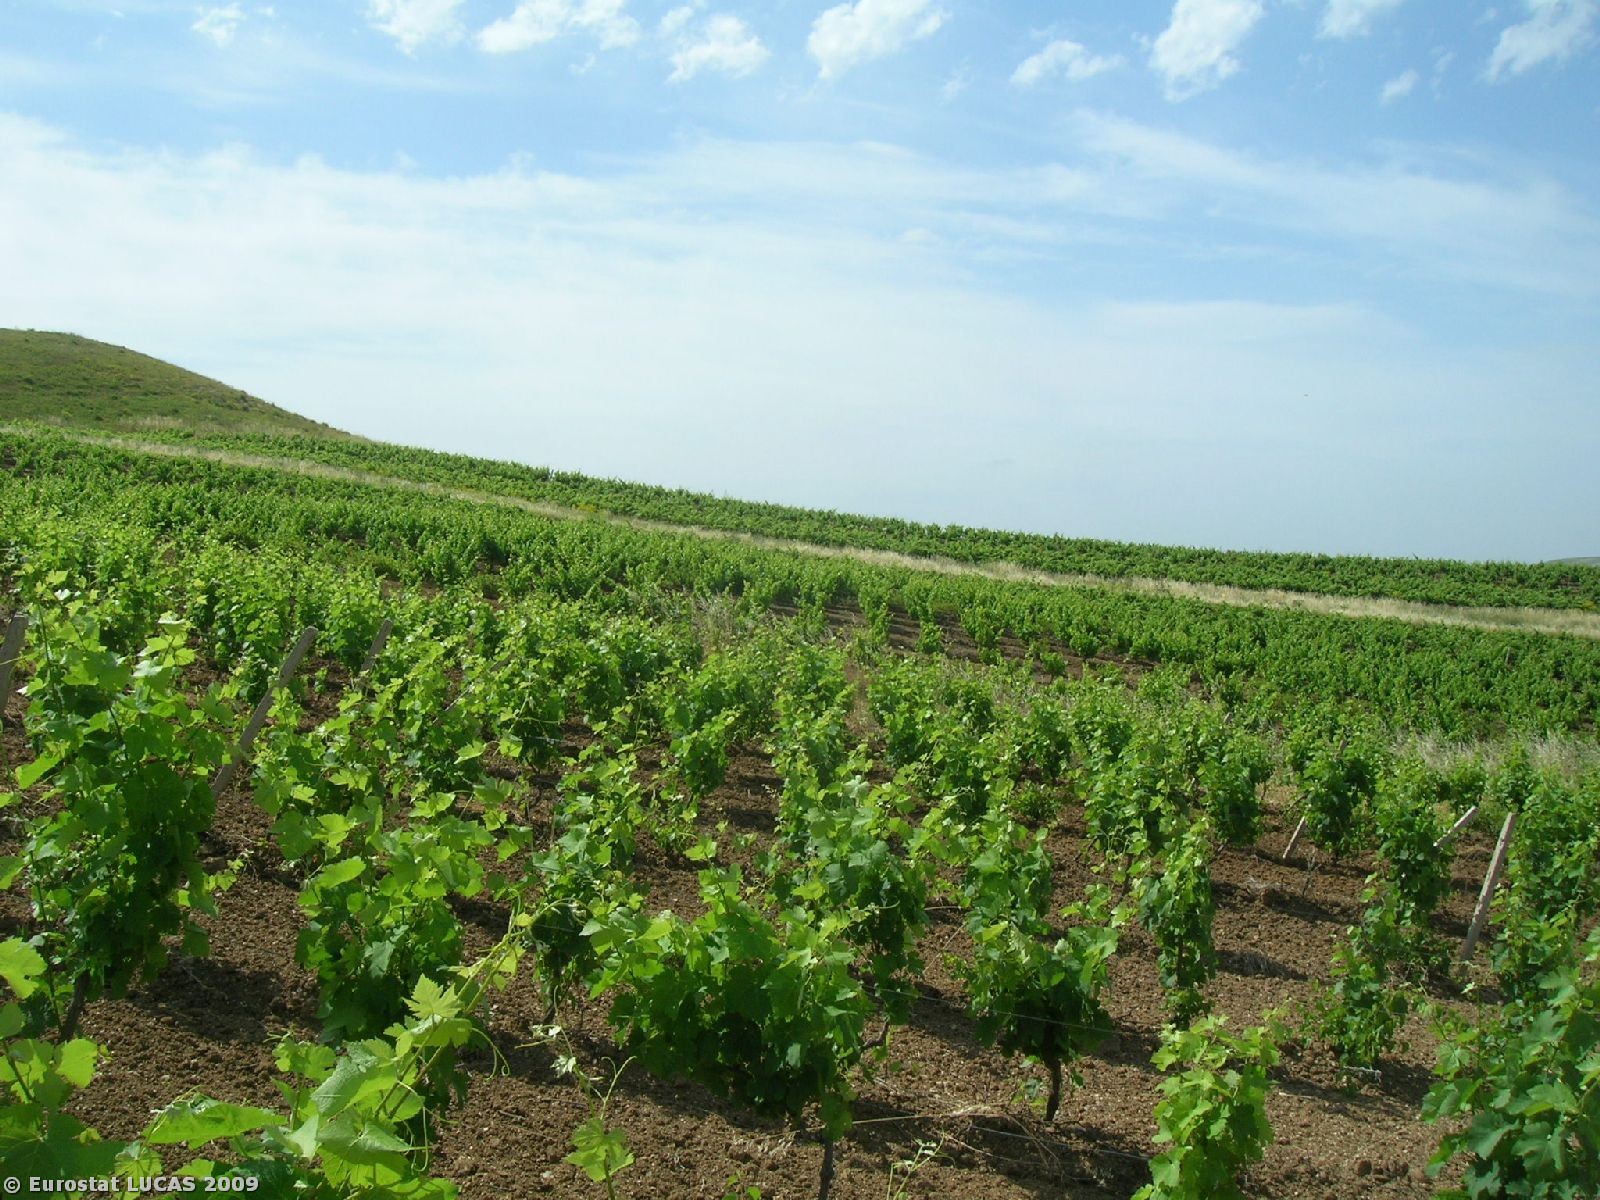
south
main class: Grassland
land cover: Spontaneously vegetated surfaces
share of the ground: > 75 %
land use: Fallow land
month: May
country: IT
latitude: 37.8202
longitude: 12.6274
